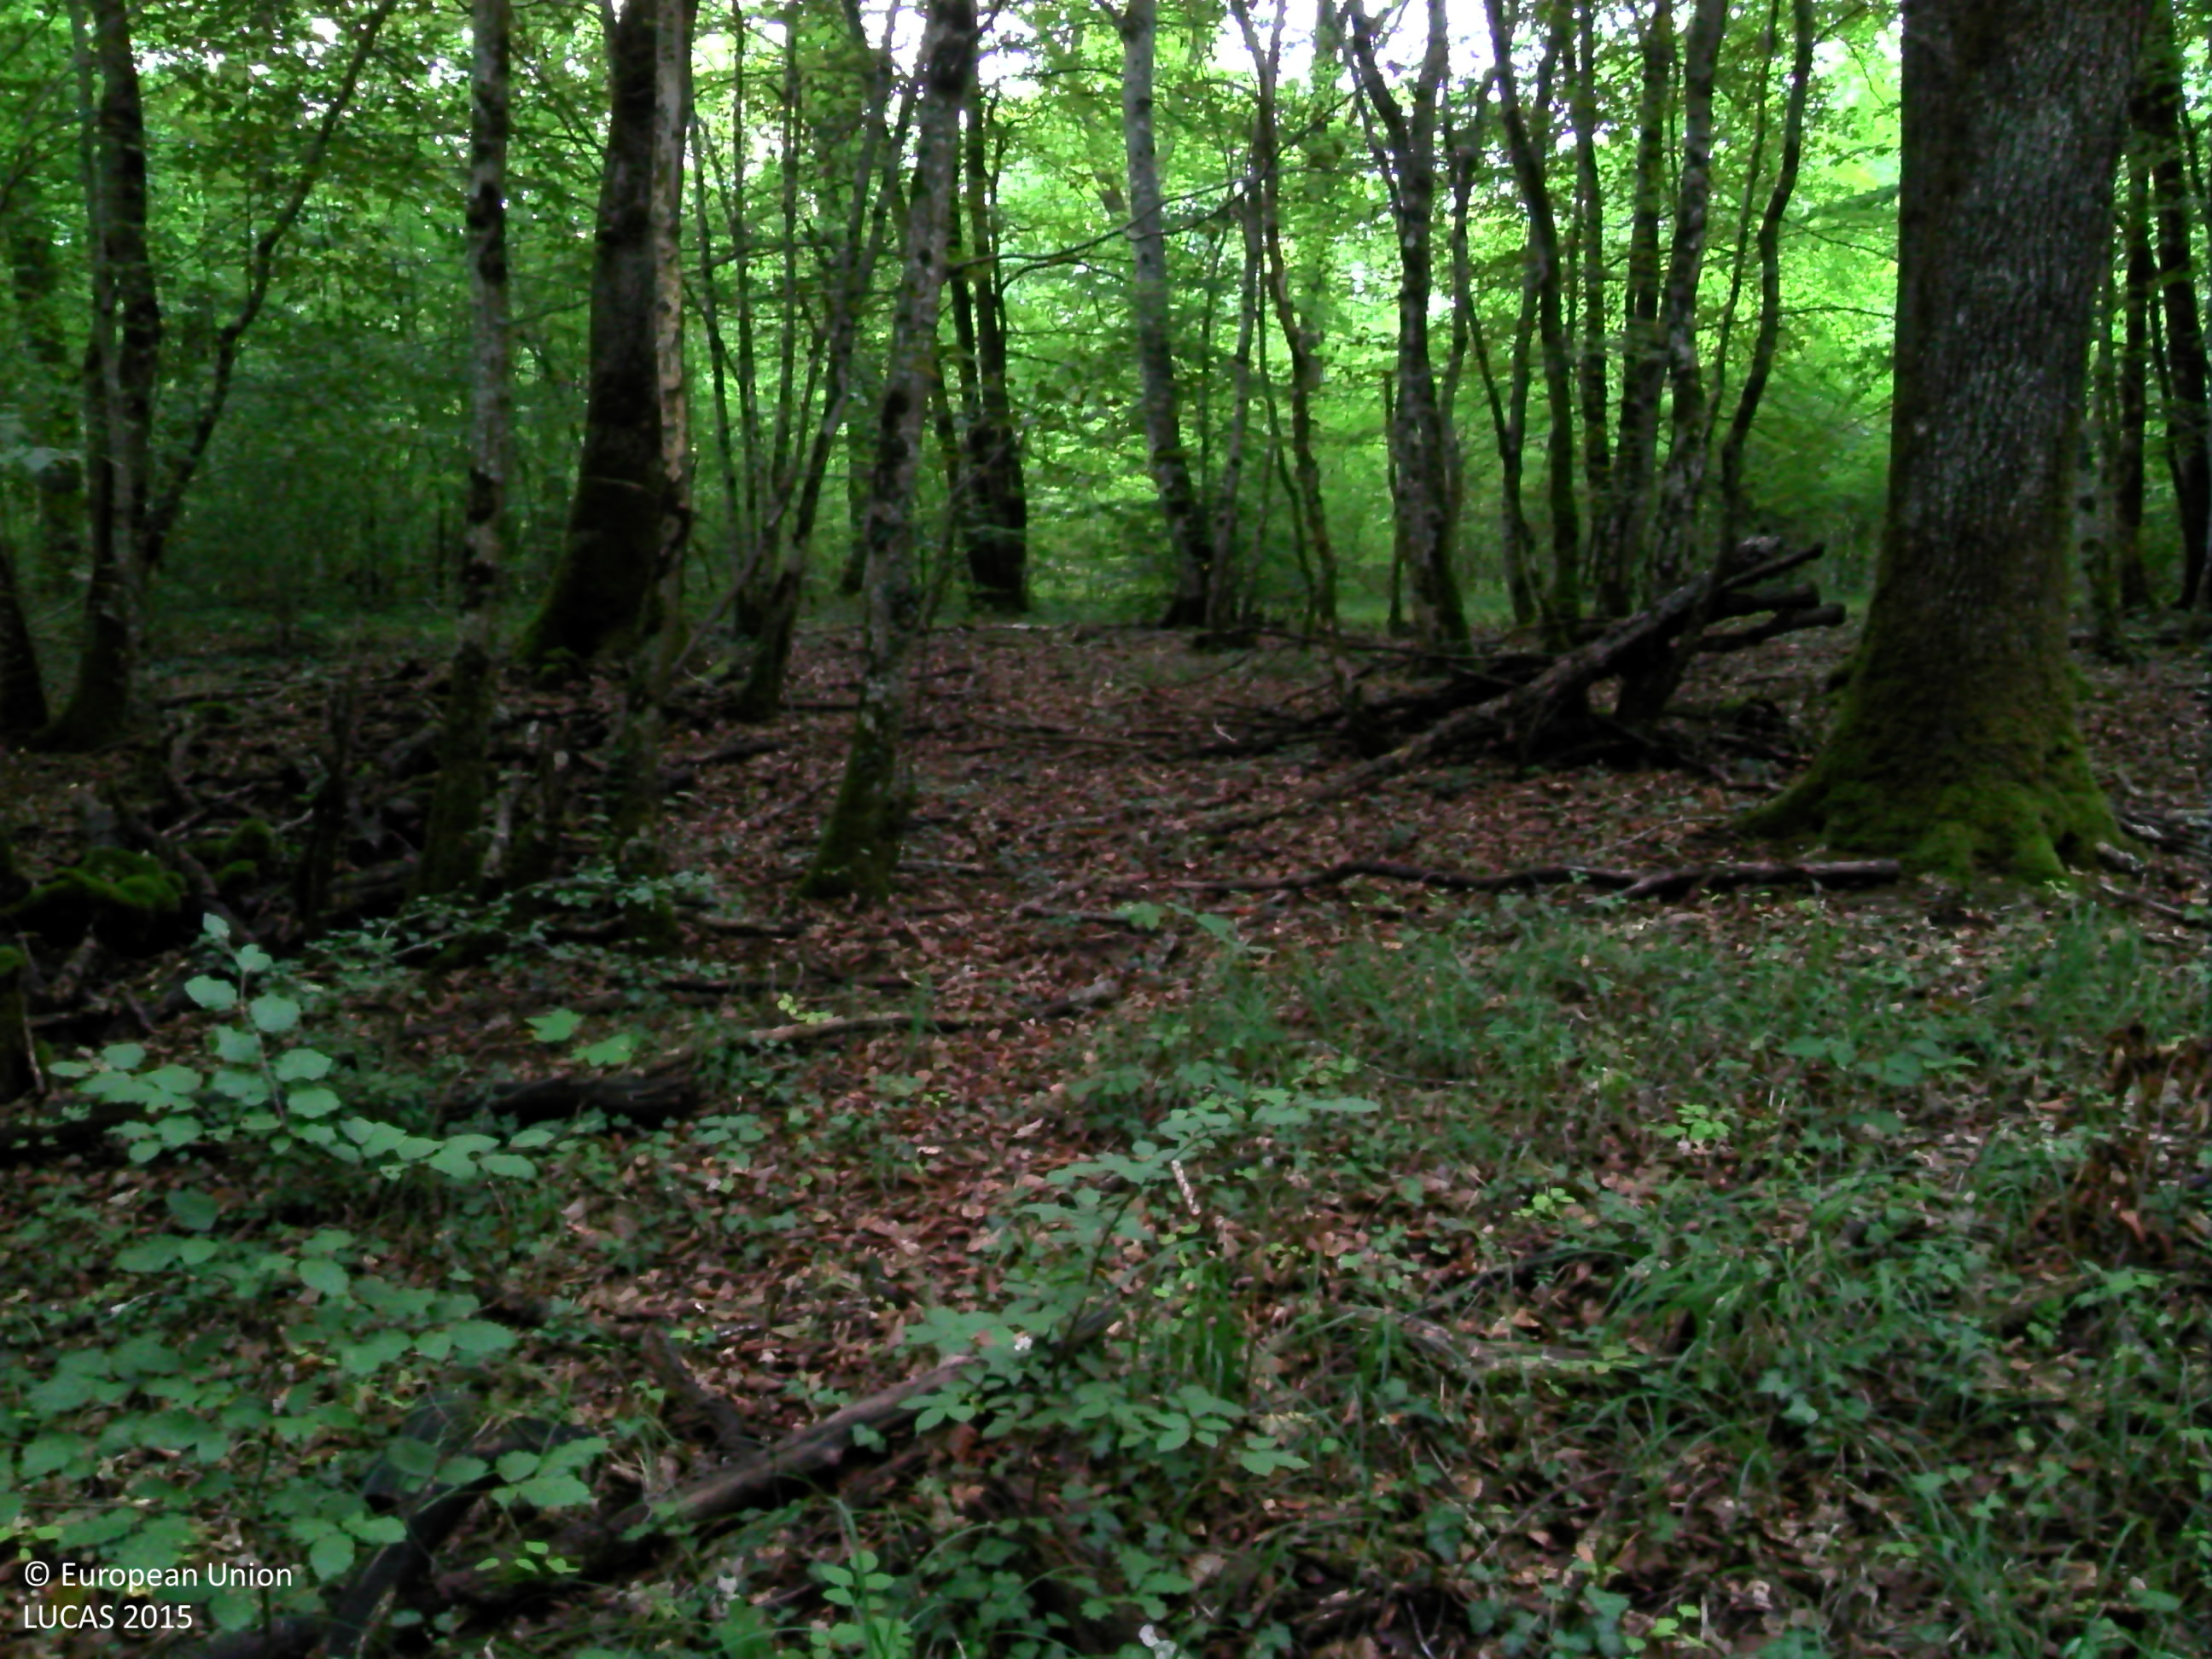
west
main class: Woodland
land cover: Broadleaved woodland
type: beech forest
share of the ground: > 75 %
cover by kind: broadleaved forest trees 85 %, herbaceous plants 10 %, shrubs 5 %
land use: Forestry
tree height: > 5 m
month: September
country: FR
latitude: 48.1919
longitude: 4.8193
